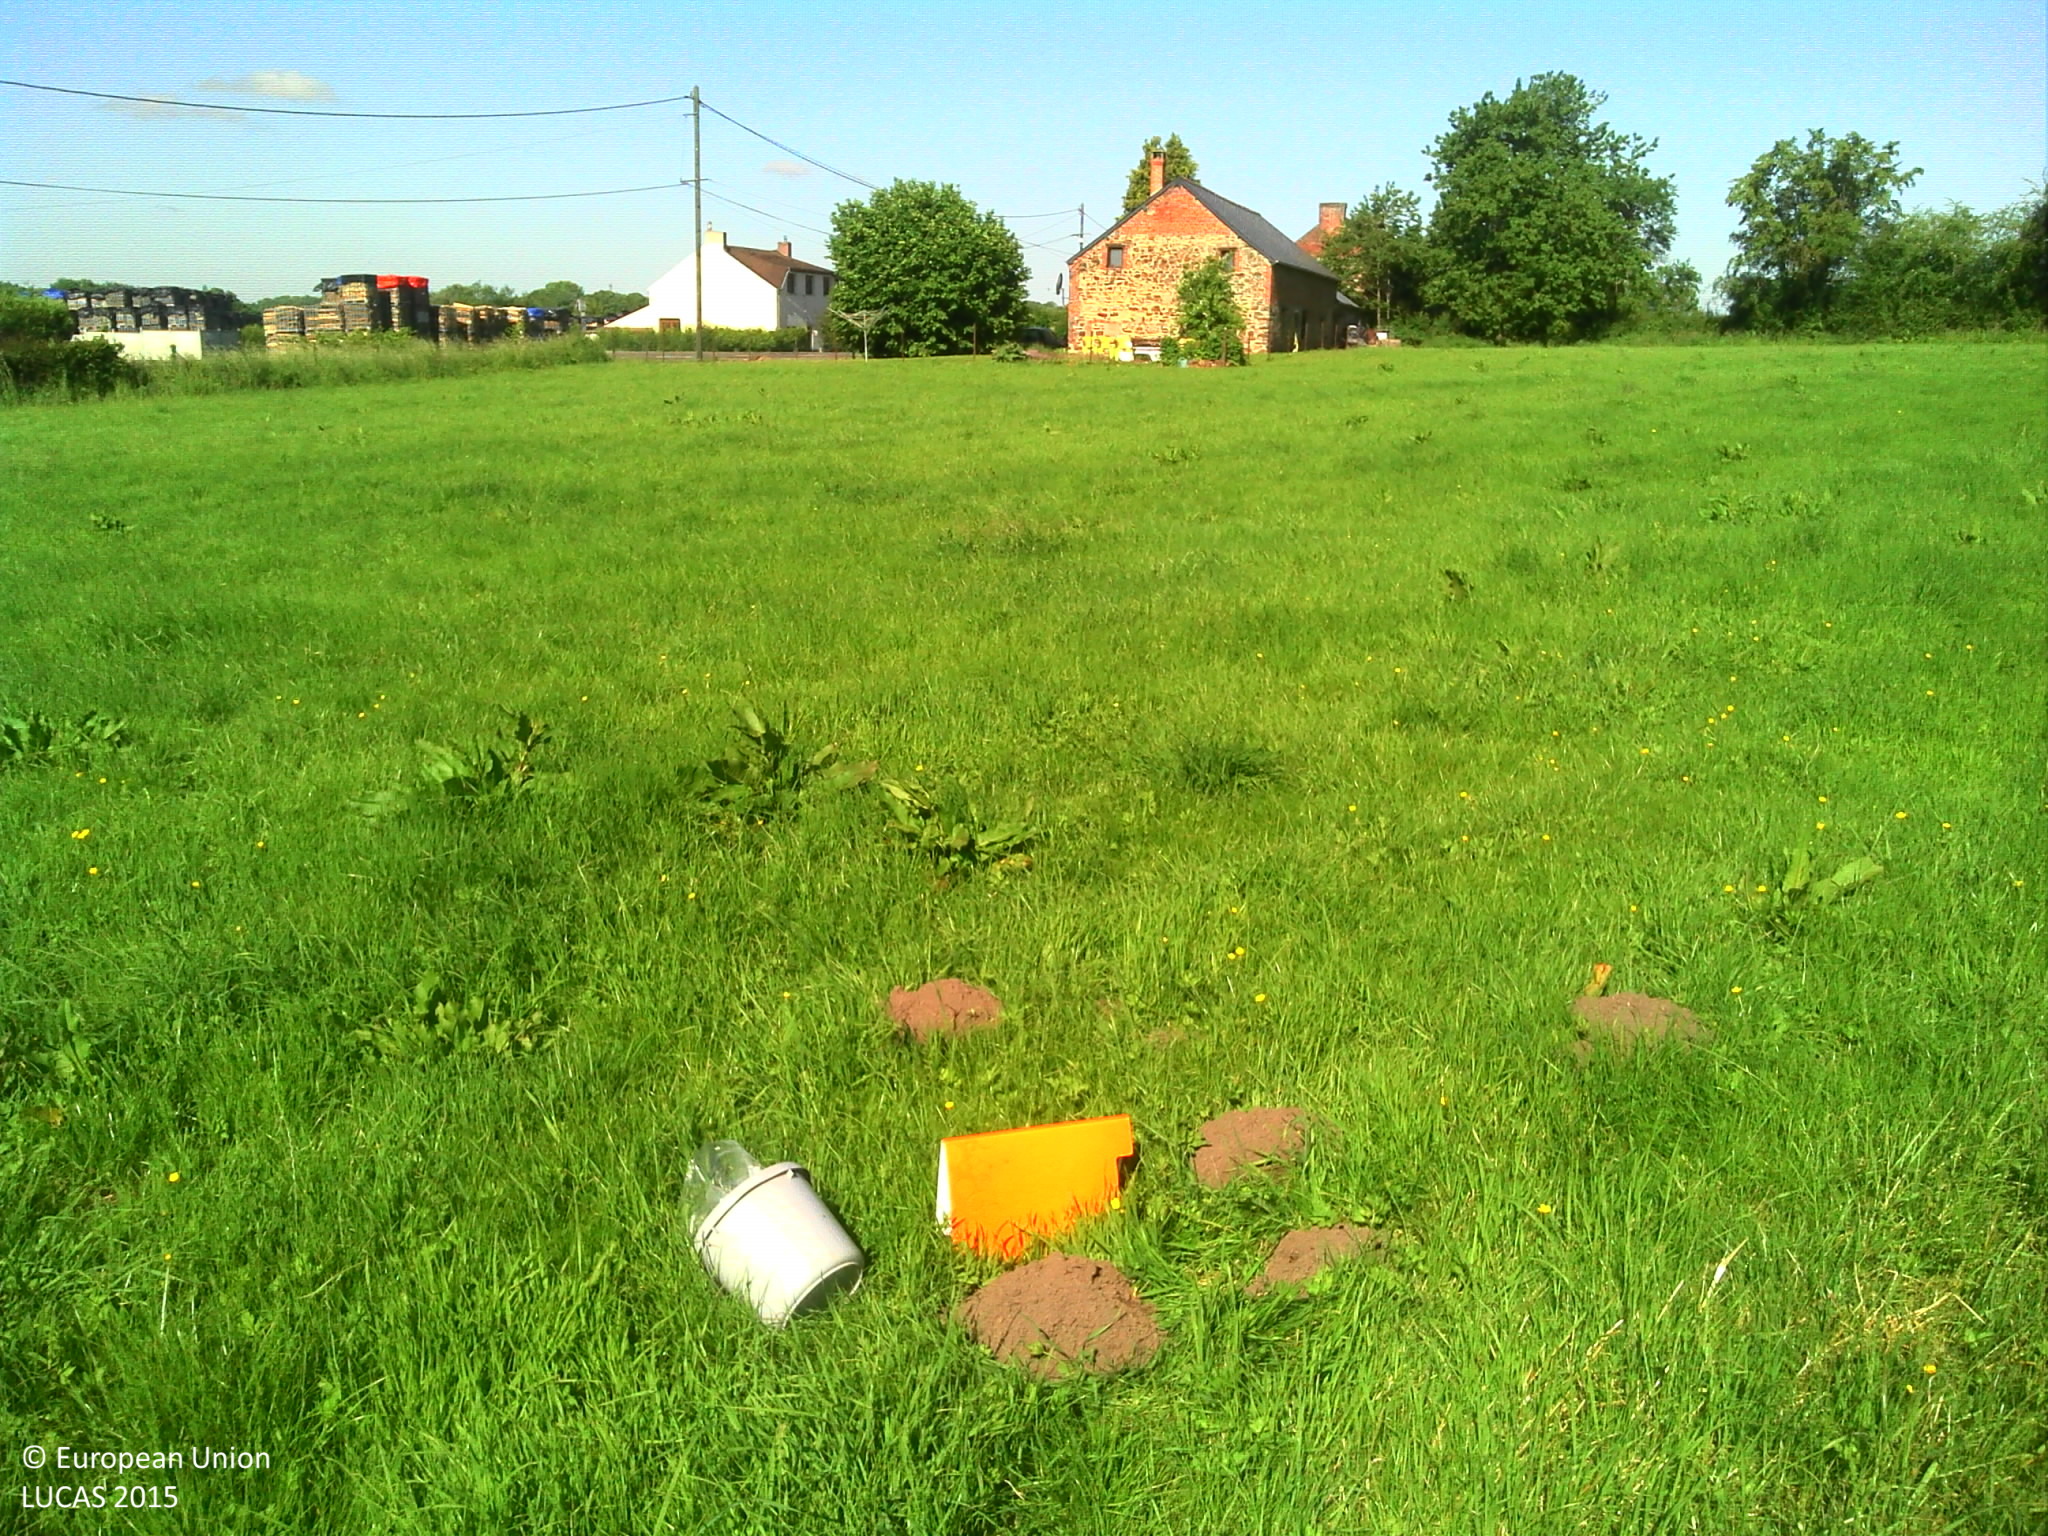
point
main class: Grassland
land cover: Grassland without tree/shrub cover
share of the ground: > 75 %
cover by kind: herbaceous plants 100 %
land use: Agriculture (excluding fallow land and kitchen gardens)
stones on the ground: < 10 %
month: June
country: FR
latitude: 49.9564
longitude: 4.0428
